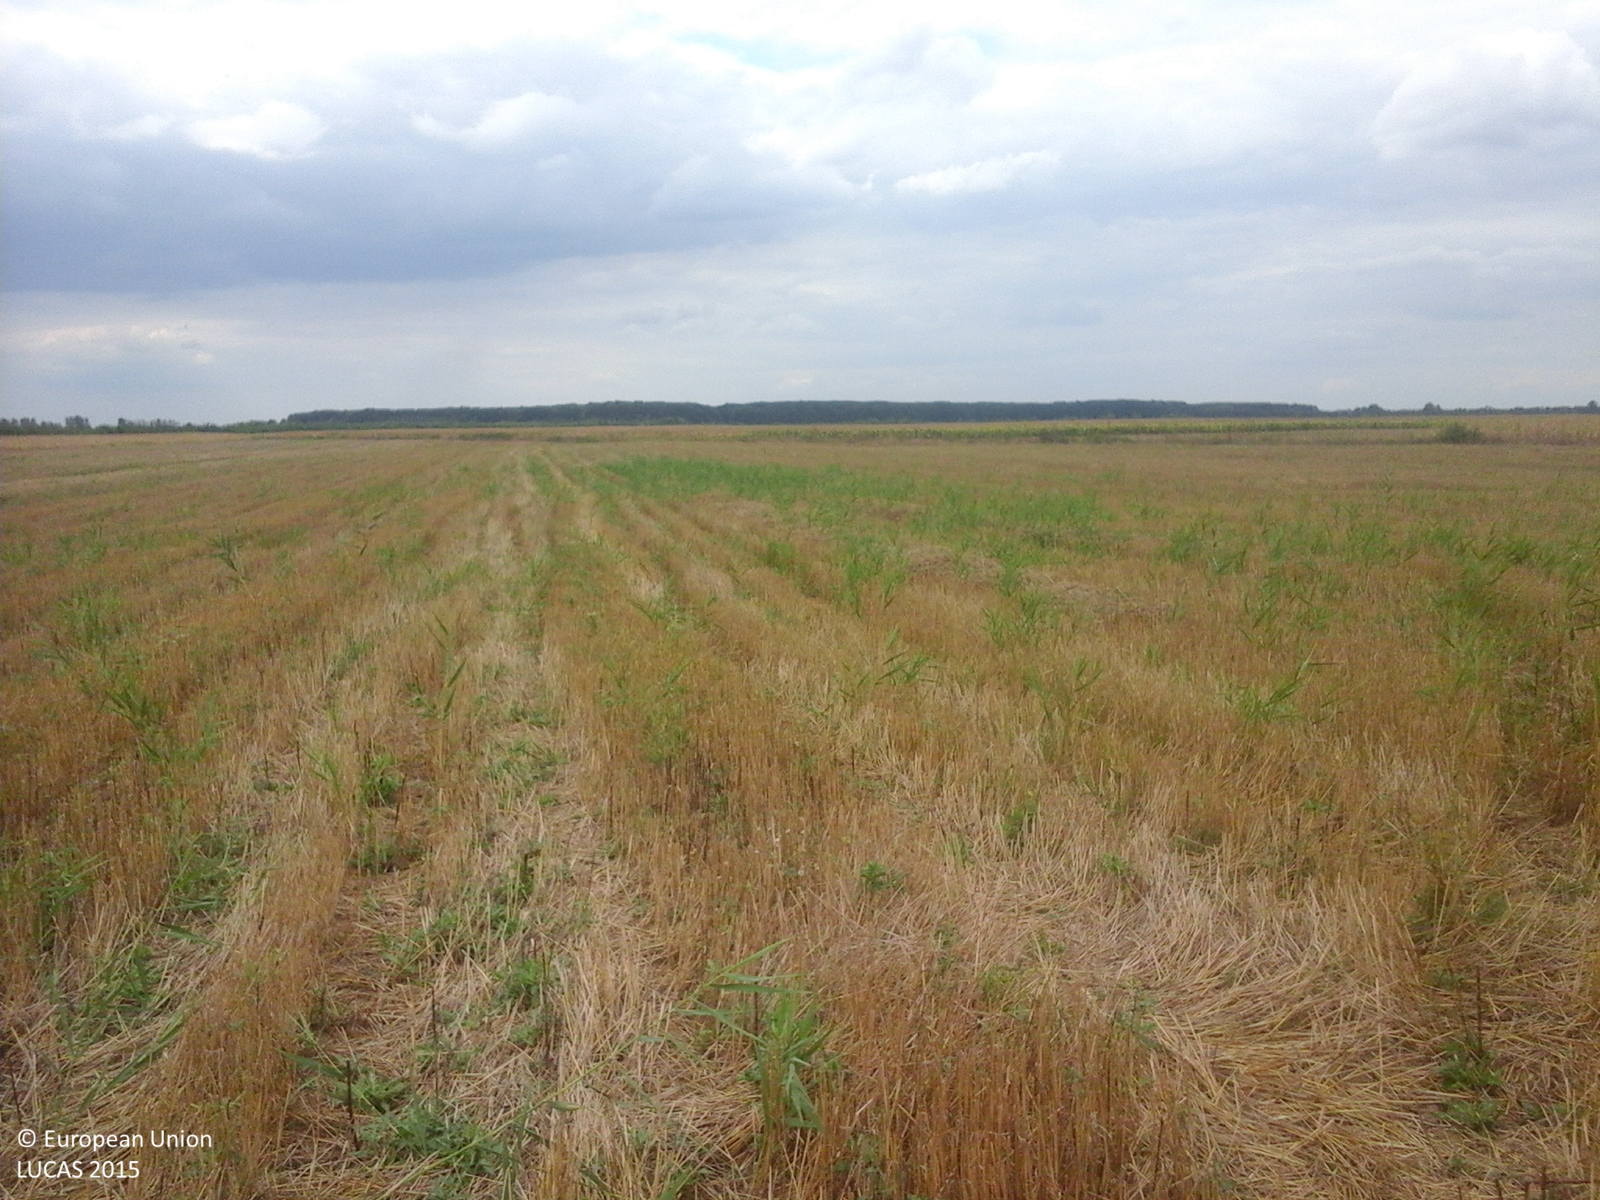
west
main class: Cropland
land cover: Common wheat
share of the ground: > 75 %
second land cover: Spontaneously vegetated surfaces
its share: 25 - 50 %
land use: Agriculture (excluding fallow land and kitchen gardens)
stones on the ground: < 10 %
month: September
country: RO
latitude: 47.8769
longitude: 22.7792
